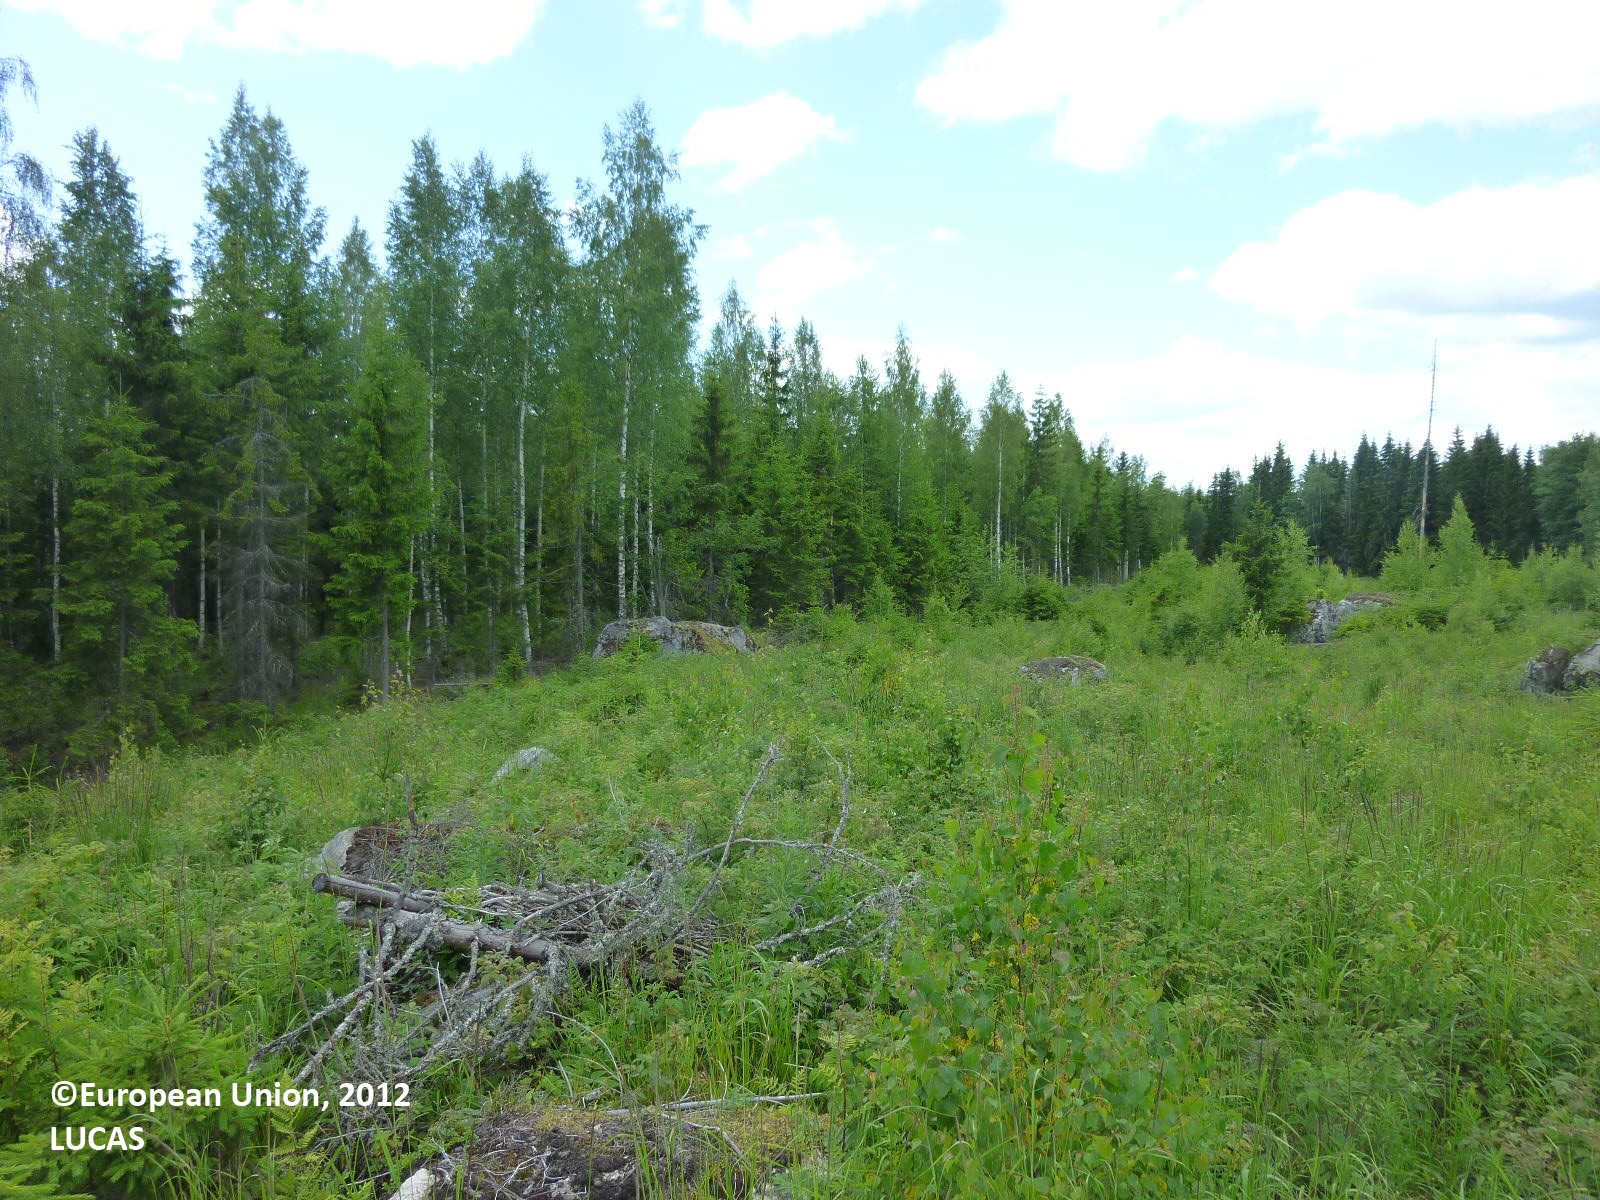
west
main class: Woodland
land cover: Spruce dominated mixed woodland
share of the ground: 50 - 75 %
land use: Forestry
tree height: < 5 m
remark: Clear cut
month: July
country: FI
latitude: 61.3794
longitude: 22.2437
